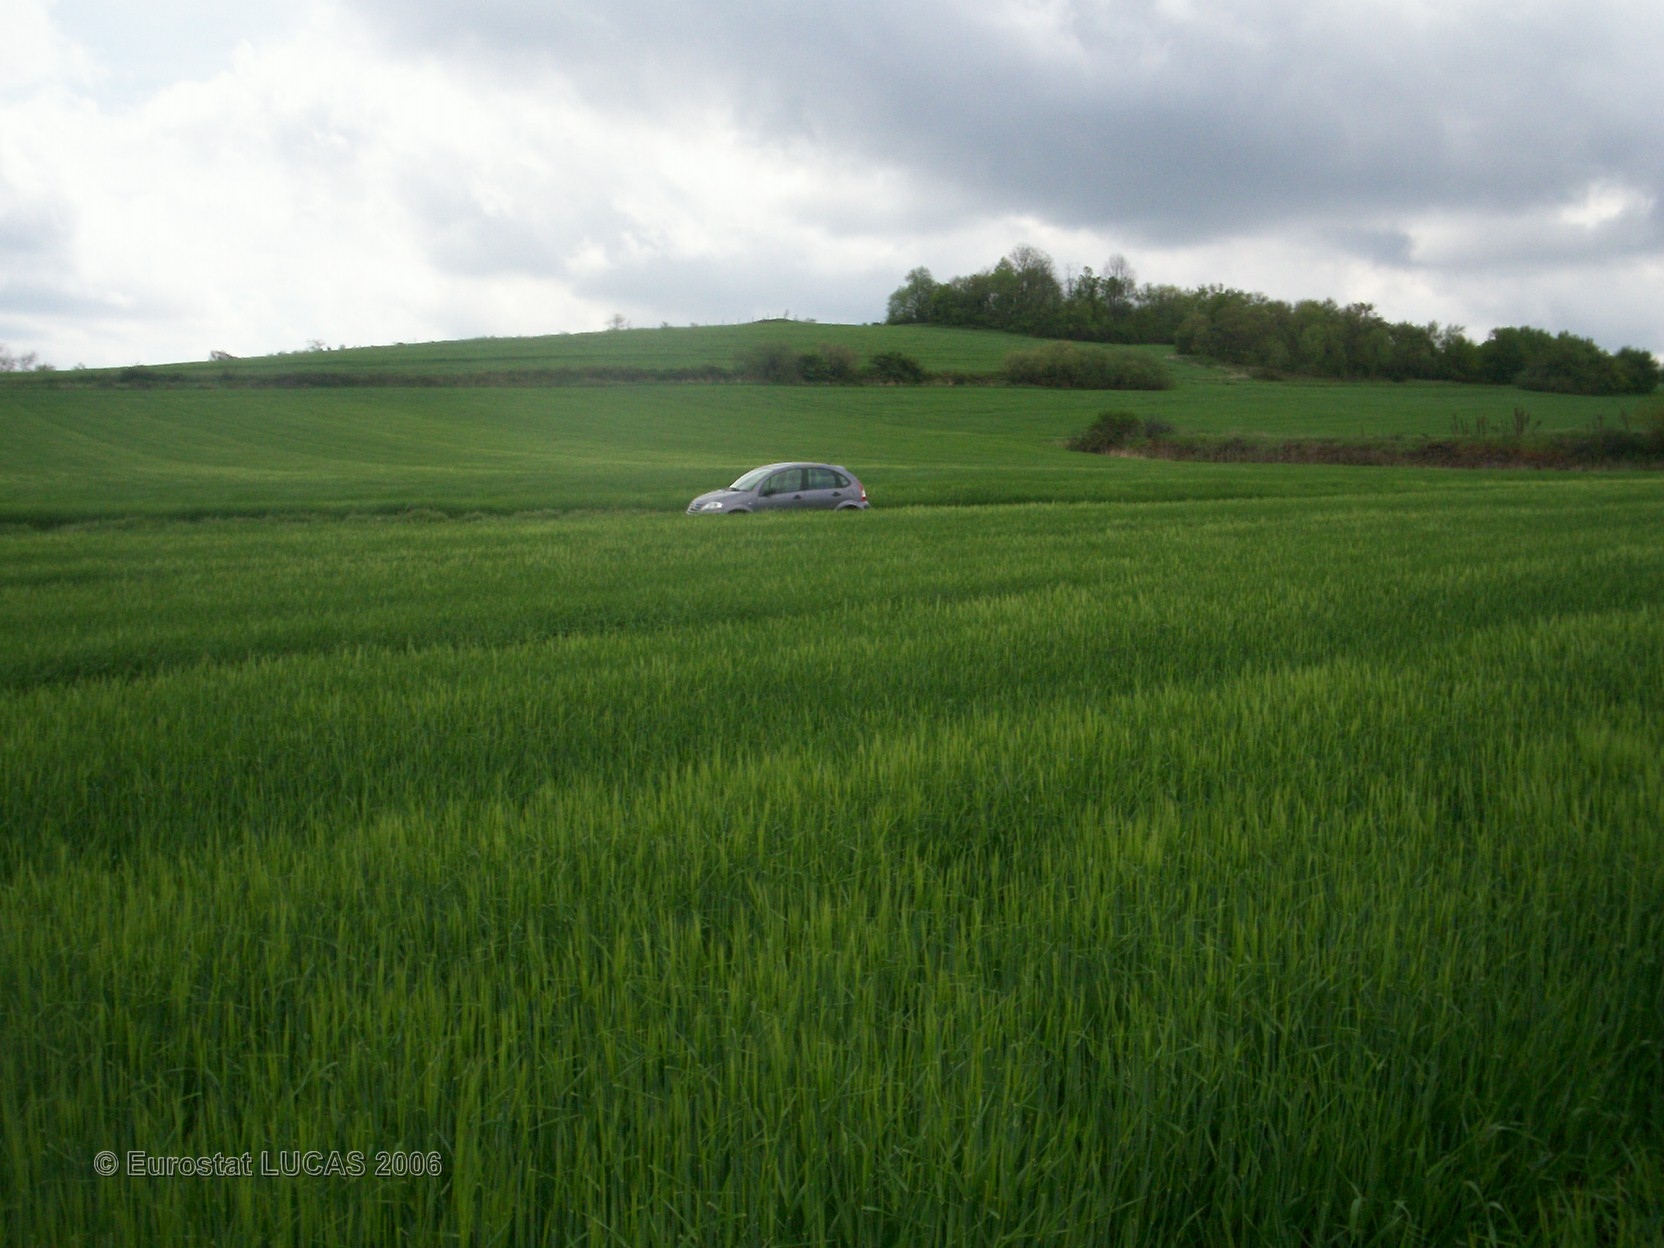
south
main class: Cropland
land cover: Barley
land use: Agriculture (excluding fallow land and kitchen gardens)
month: May
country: FR
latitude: 45.6638
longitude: 3.1850
